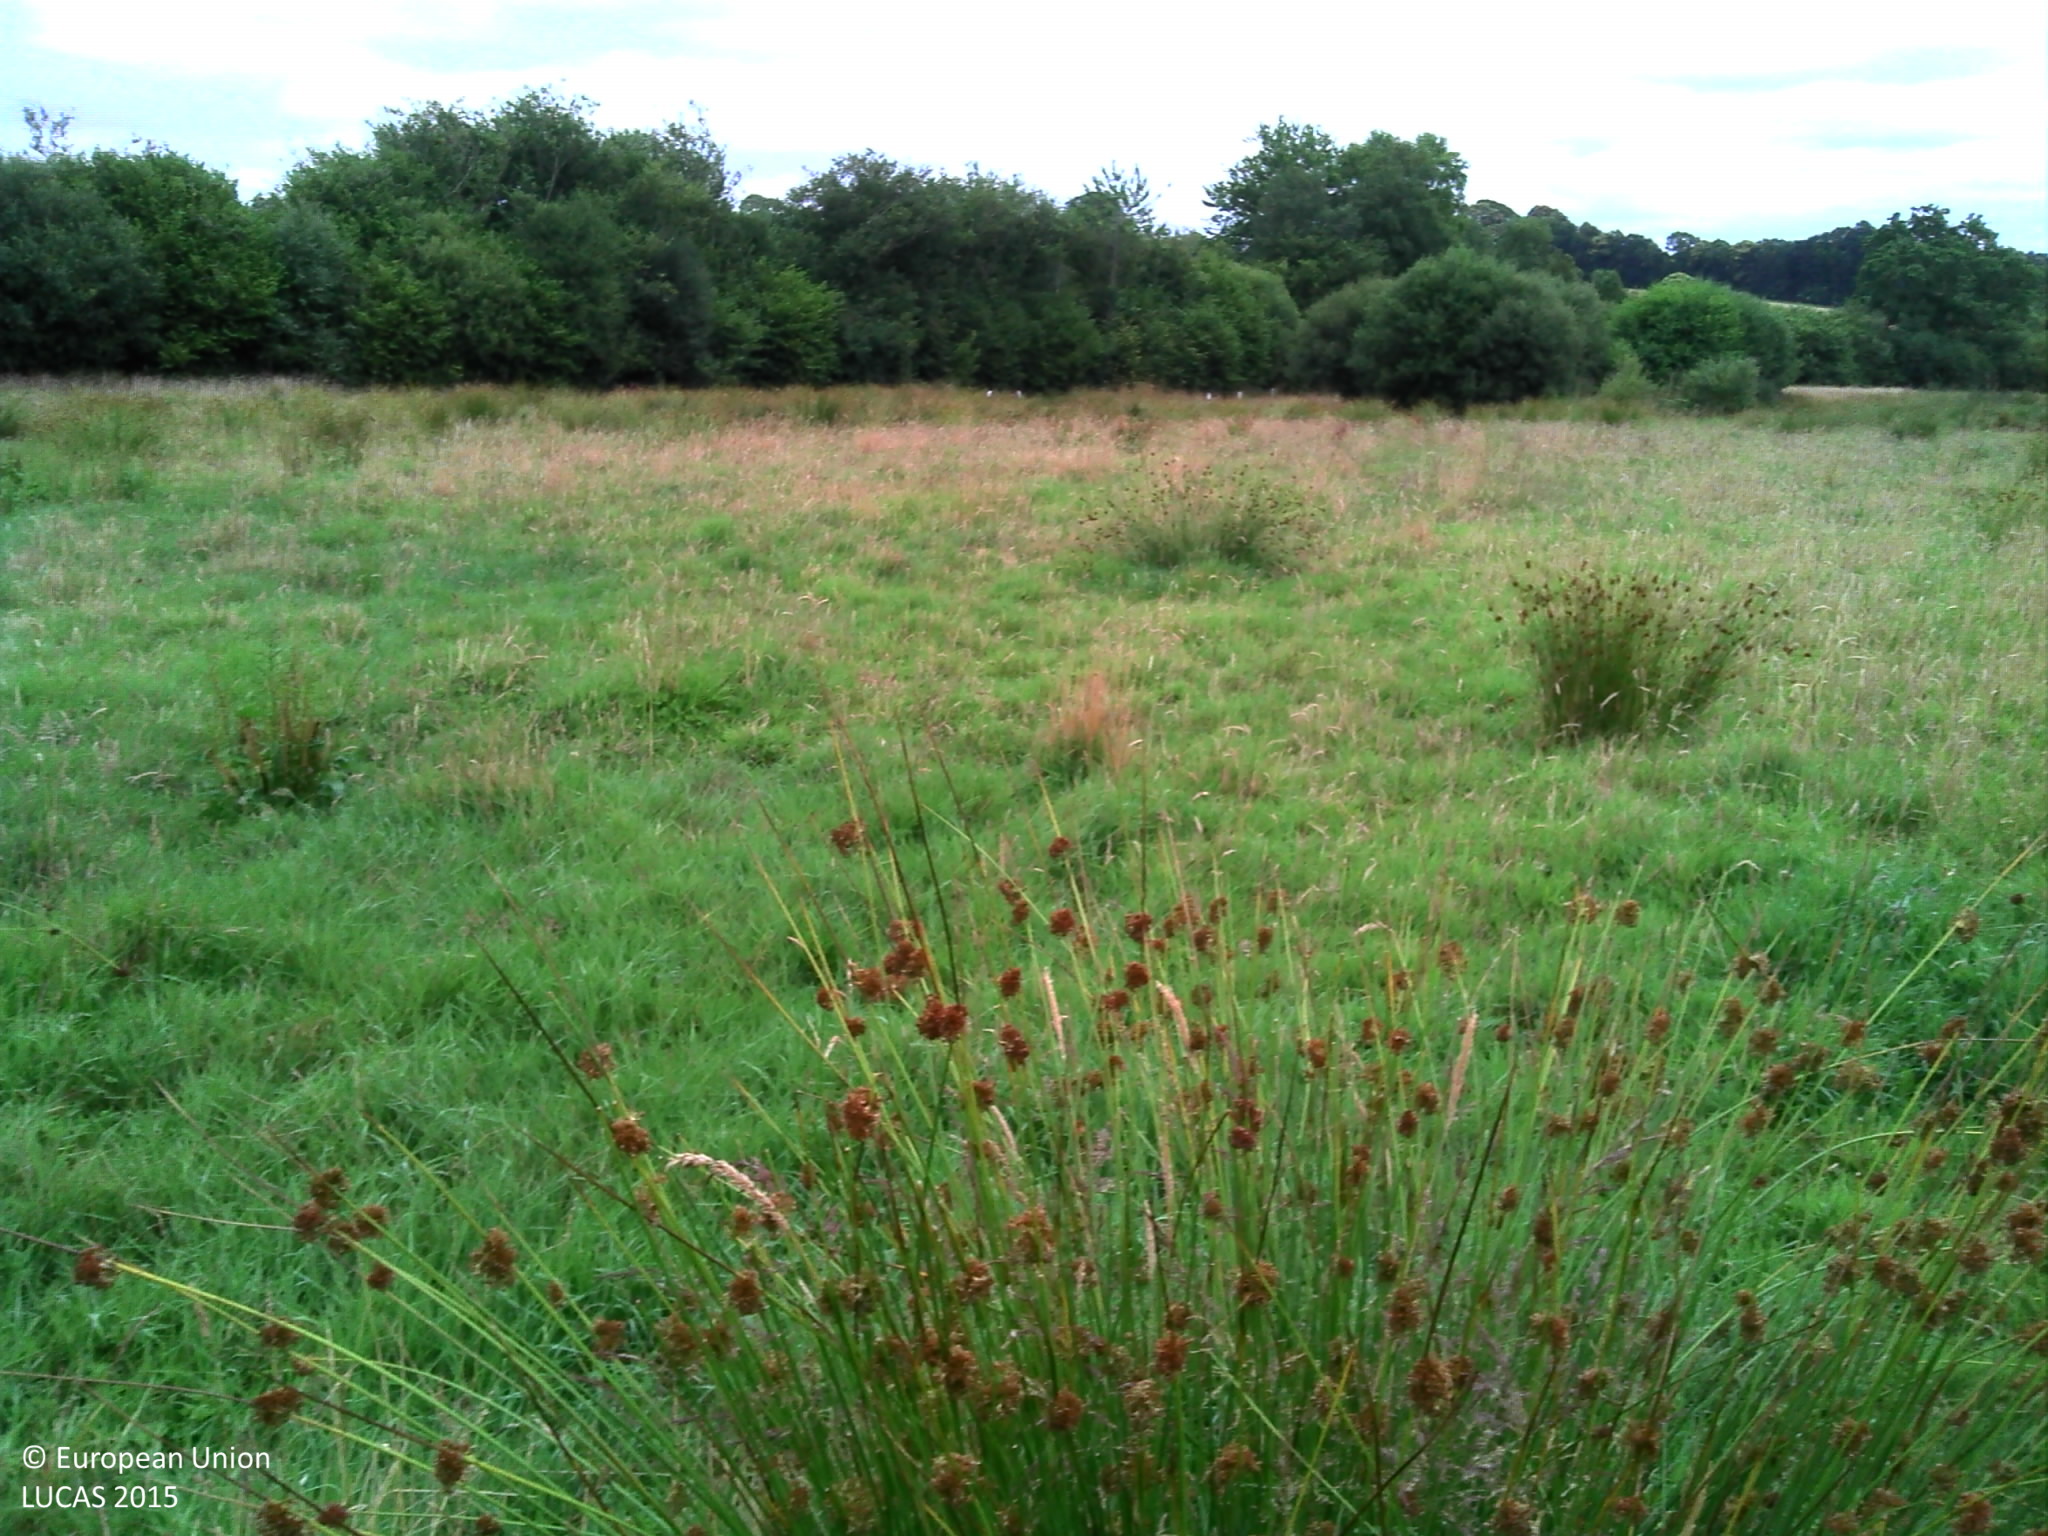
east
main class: Grassland
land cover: Grassland without tree/shrub cover
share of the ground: > 75 %
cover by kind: herbaceous plants 100 %
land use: Agriculture (excluding fallow land and kitchen gardens)
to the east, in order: Grassland without tree/shrub cover; Fences; Rivers and streams; Broadleaved woodland; Common wheat; Electric lines; Common wheat; Electric lines; Barley; Lines of trees; Managed hedges; Grassland without tree/shrub cover
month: July
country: FR
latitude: 48.1340
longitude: -3.6656
